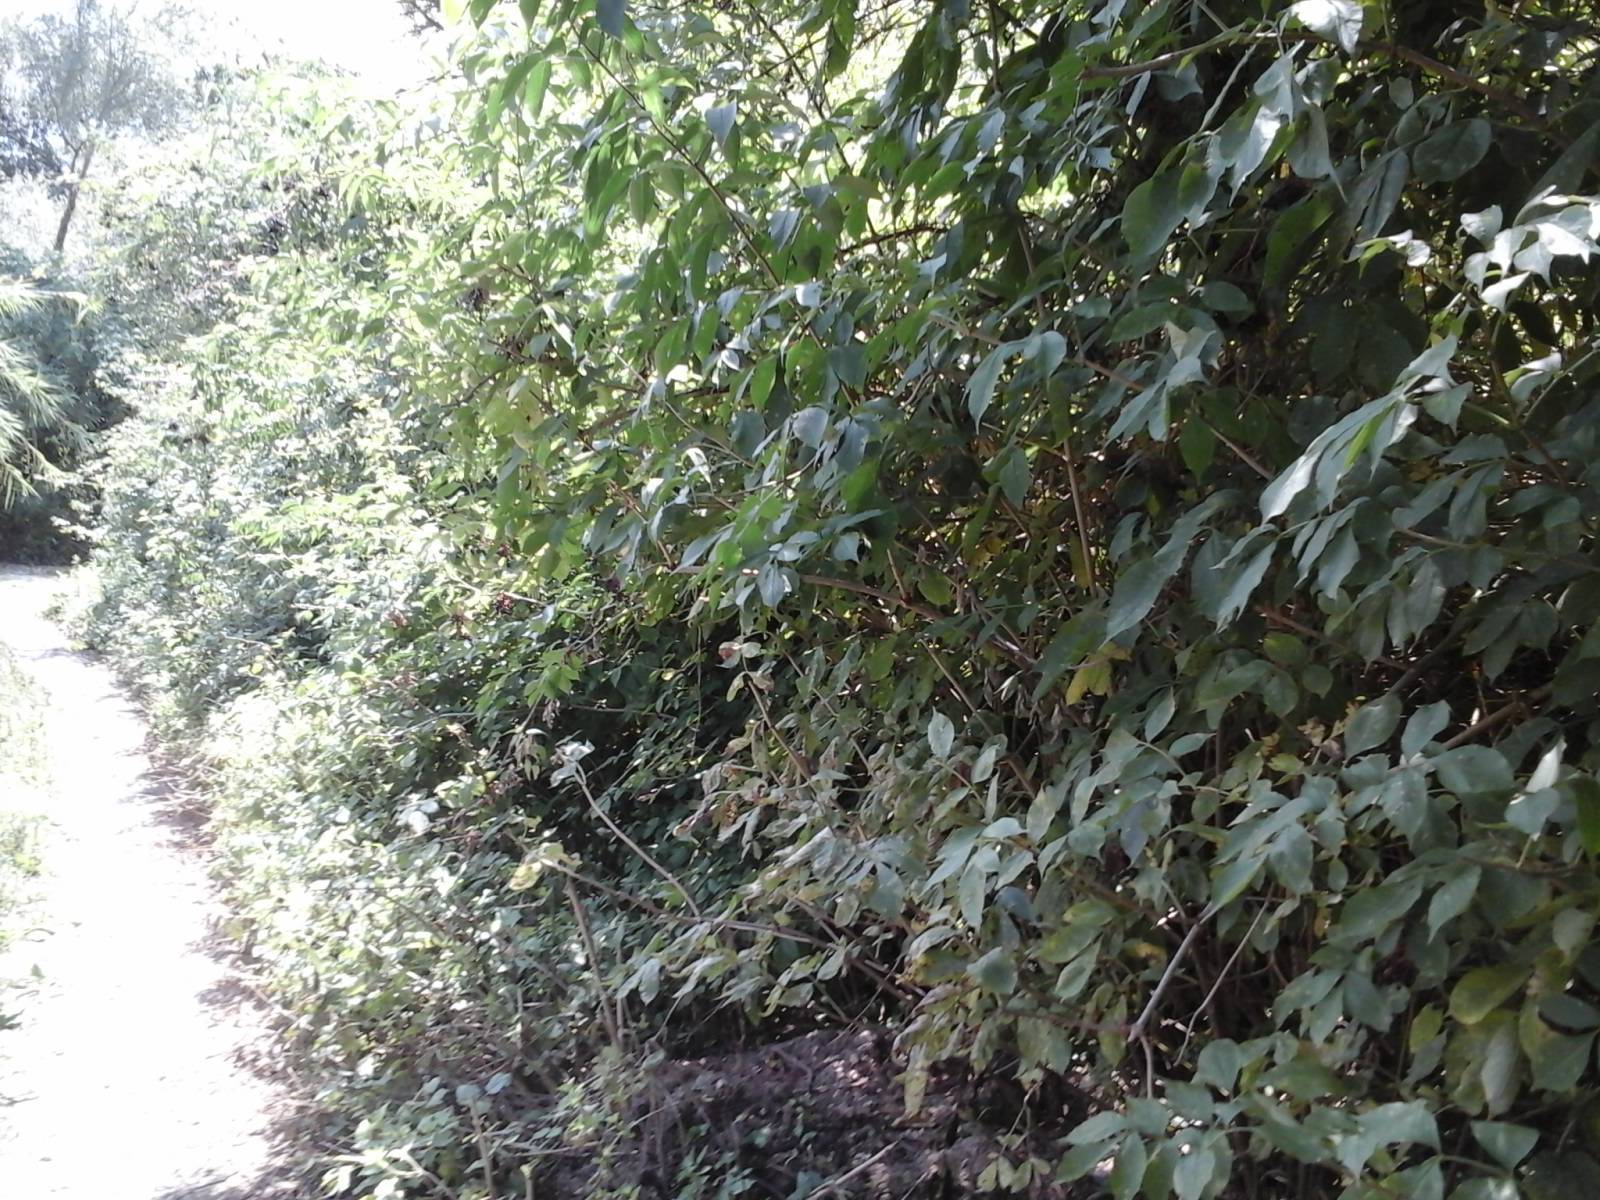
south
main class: Woodland
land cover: Broadleaved woodland
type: thermophilous deciduous forest
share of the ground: > 75 %
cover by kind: broadleaved forest trees 70 %, shrubs 30 %
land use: Semi-natural and natural areas not in use
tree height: > 5 m
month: July
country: IT
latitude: 42.2232
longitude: 12.5957
